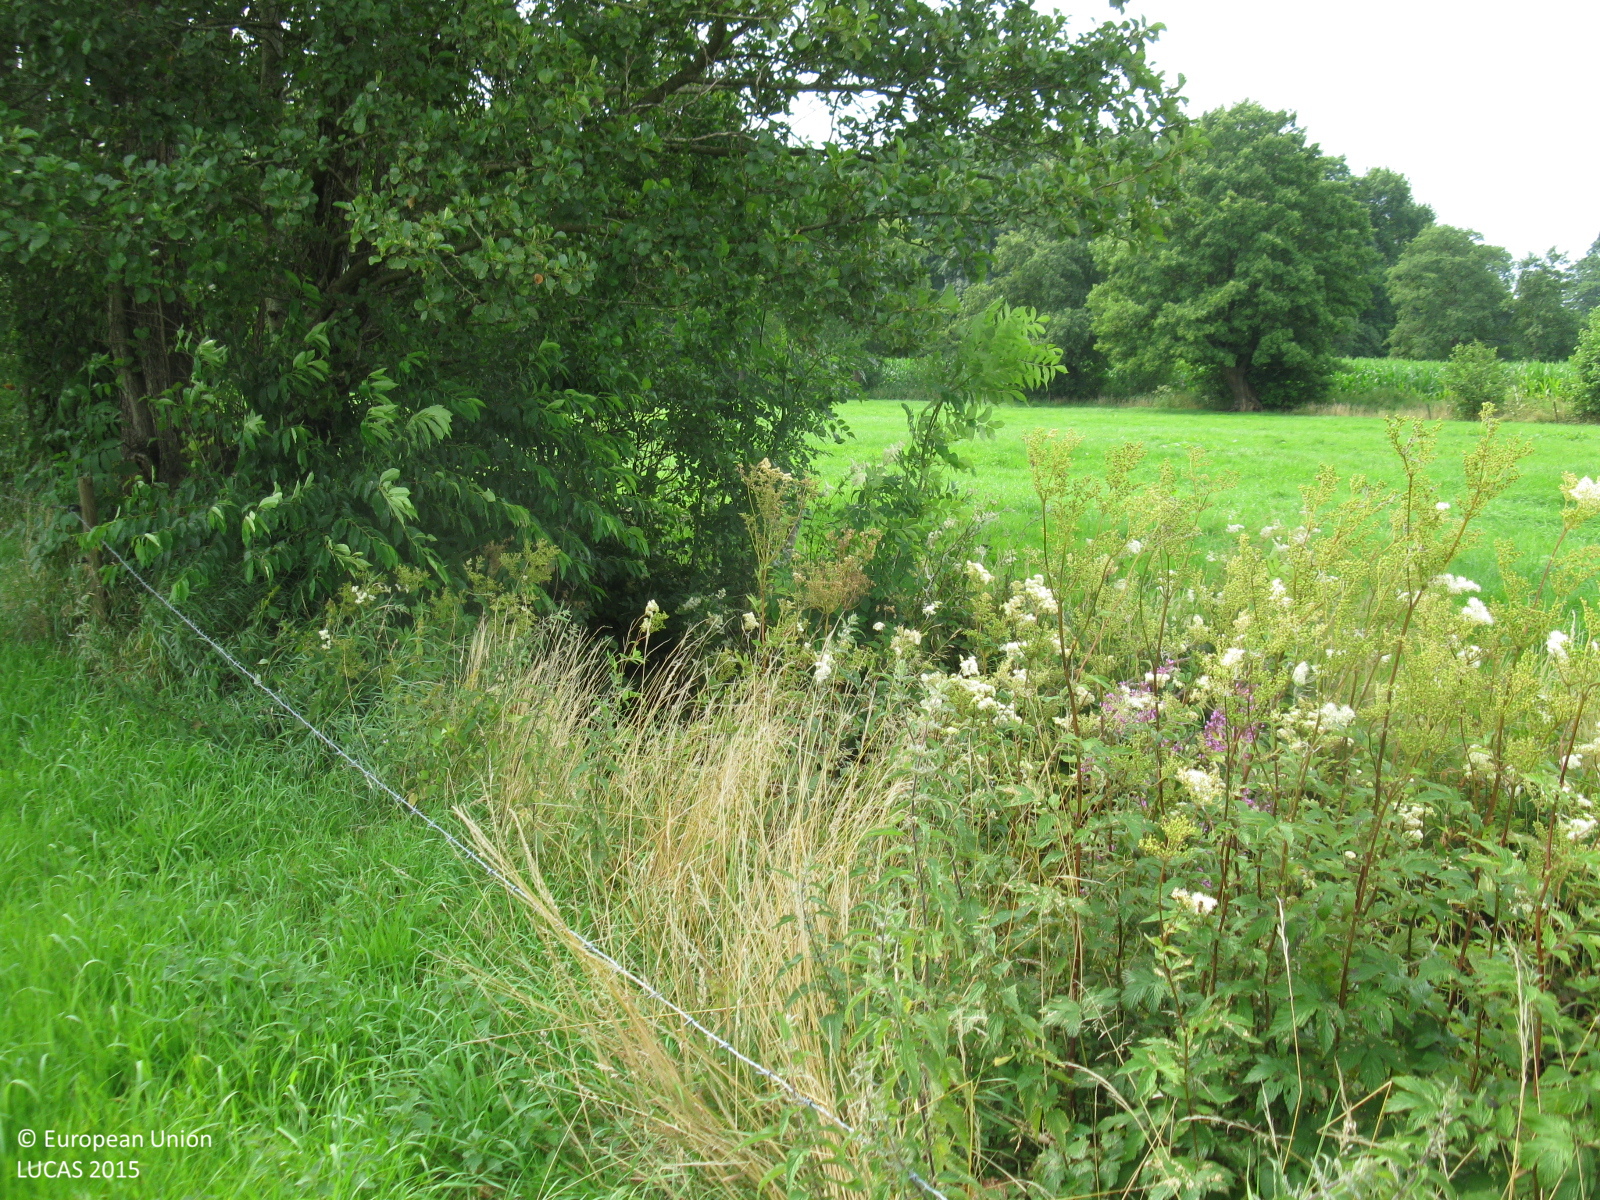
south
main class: Grassland
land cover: Grassland without tree/shrub cover
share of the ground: > 75 %
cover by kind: herbaceous plants 100 %
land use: Agriculture (excluding fallow land and kitchen gardens)
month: August
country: DE
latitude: 53.1389
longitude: 8.3413
